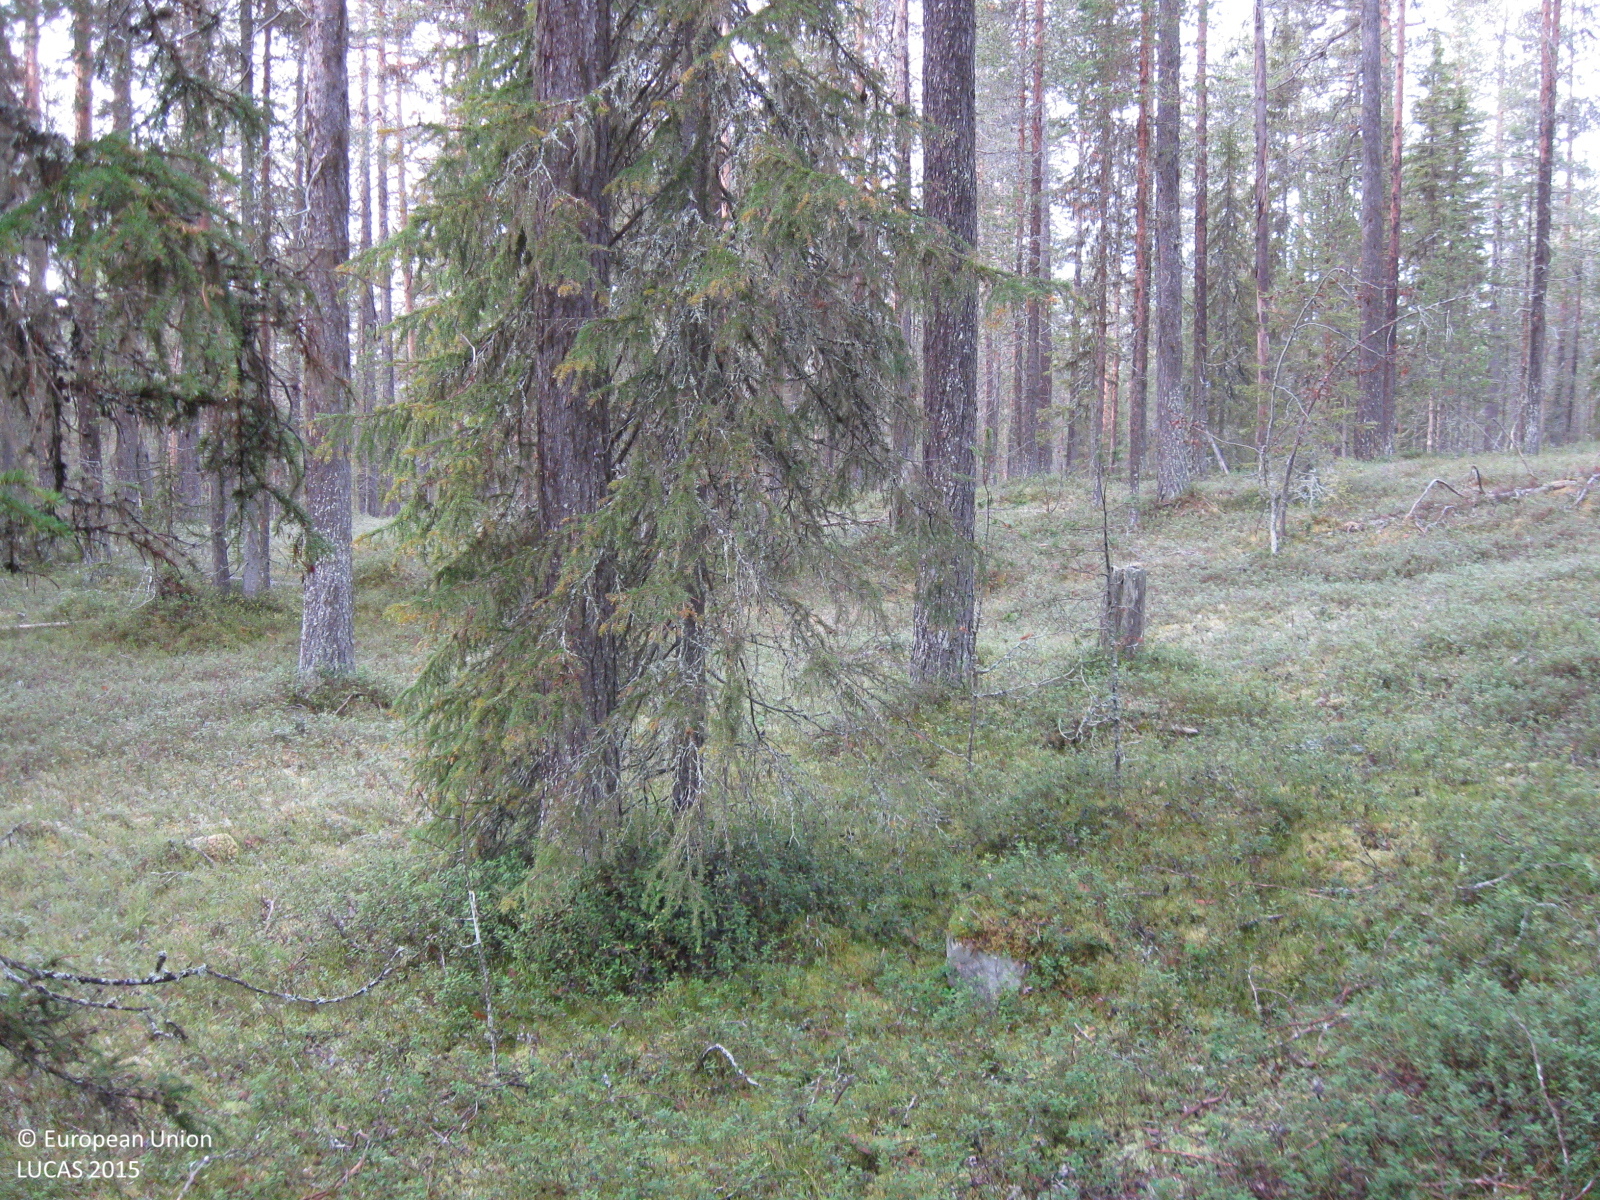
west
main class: Woodland
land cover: Pine dominated coniferous woodland
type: boreal forest
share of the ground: 50 - 75 %
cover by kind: coniferous forest trees 70 %, shrubs 15 %, lichens and mosses 10 %, herbaceous plants 5 %
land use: Forestry
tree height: > 5 m
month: October
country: SE
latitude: 66.4134
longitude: 20.9564
